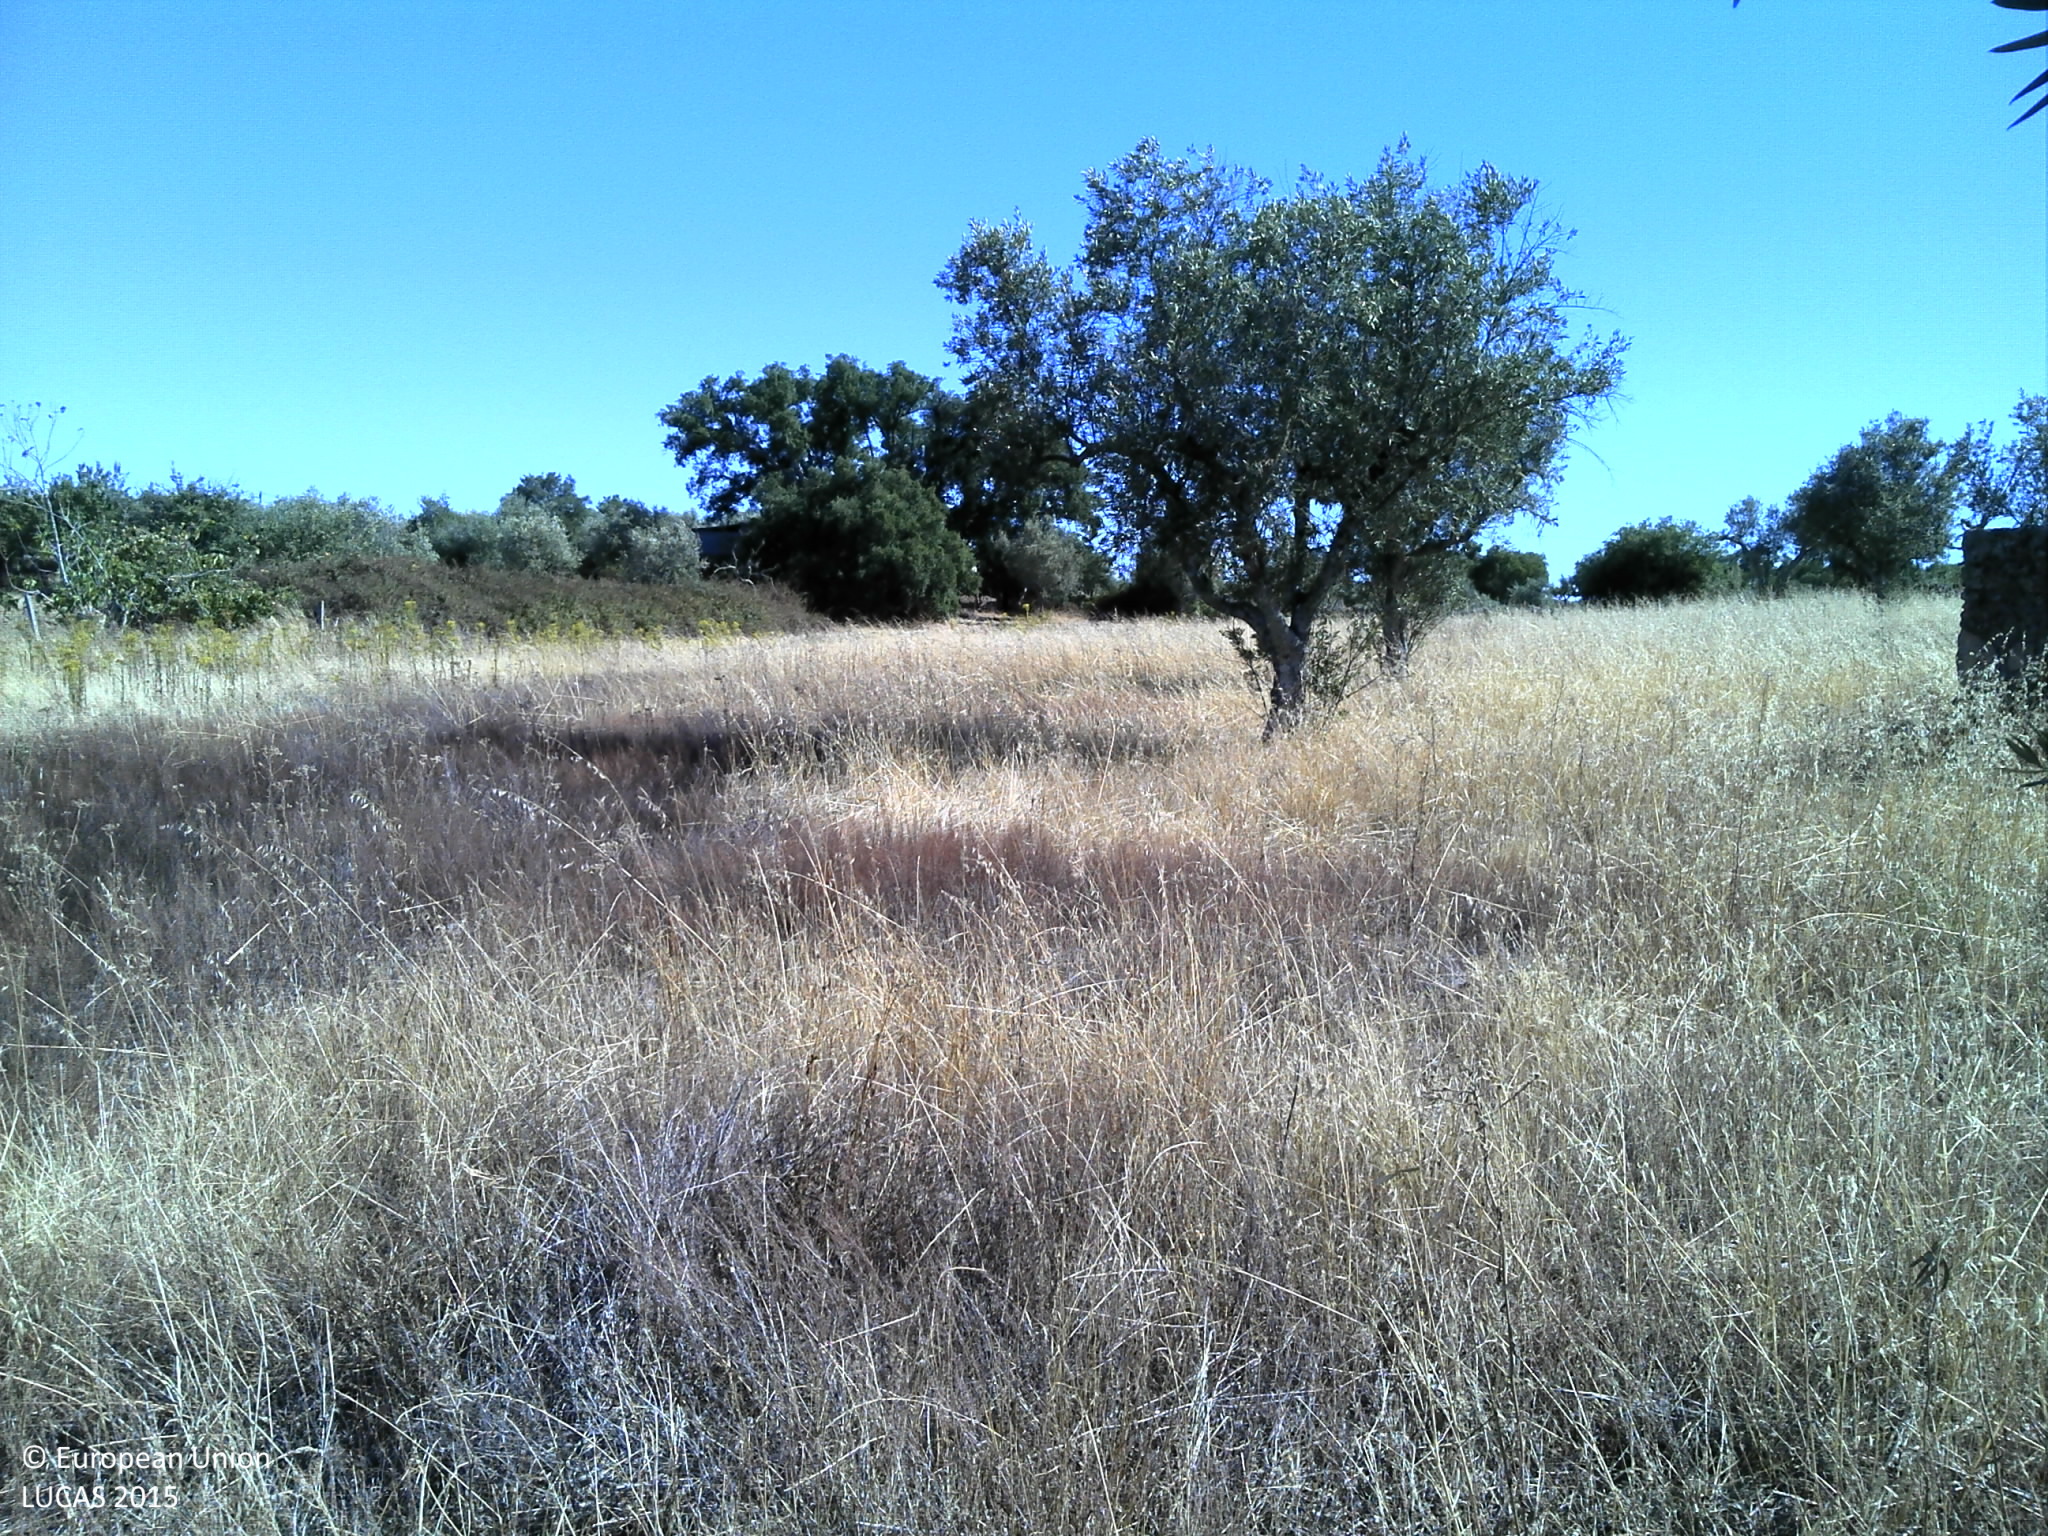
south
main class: Cropland
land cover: Olive groves
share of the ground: 10 - 25 %
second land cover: Grassland without tree/shrub cover
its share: 10 - 25 %
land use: Agriculture (excluding fallow land and kitchen gardens)
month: August
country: PT
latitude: 39.5063
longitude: -7.5275
